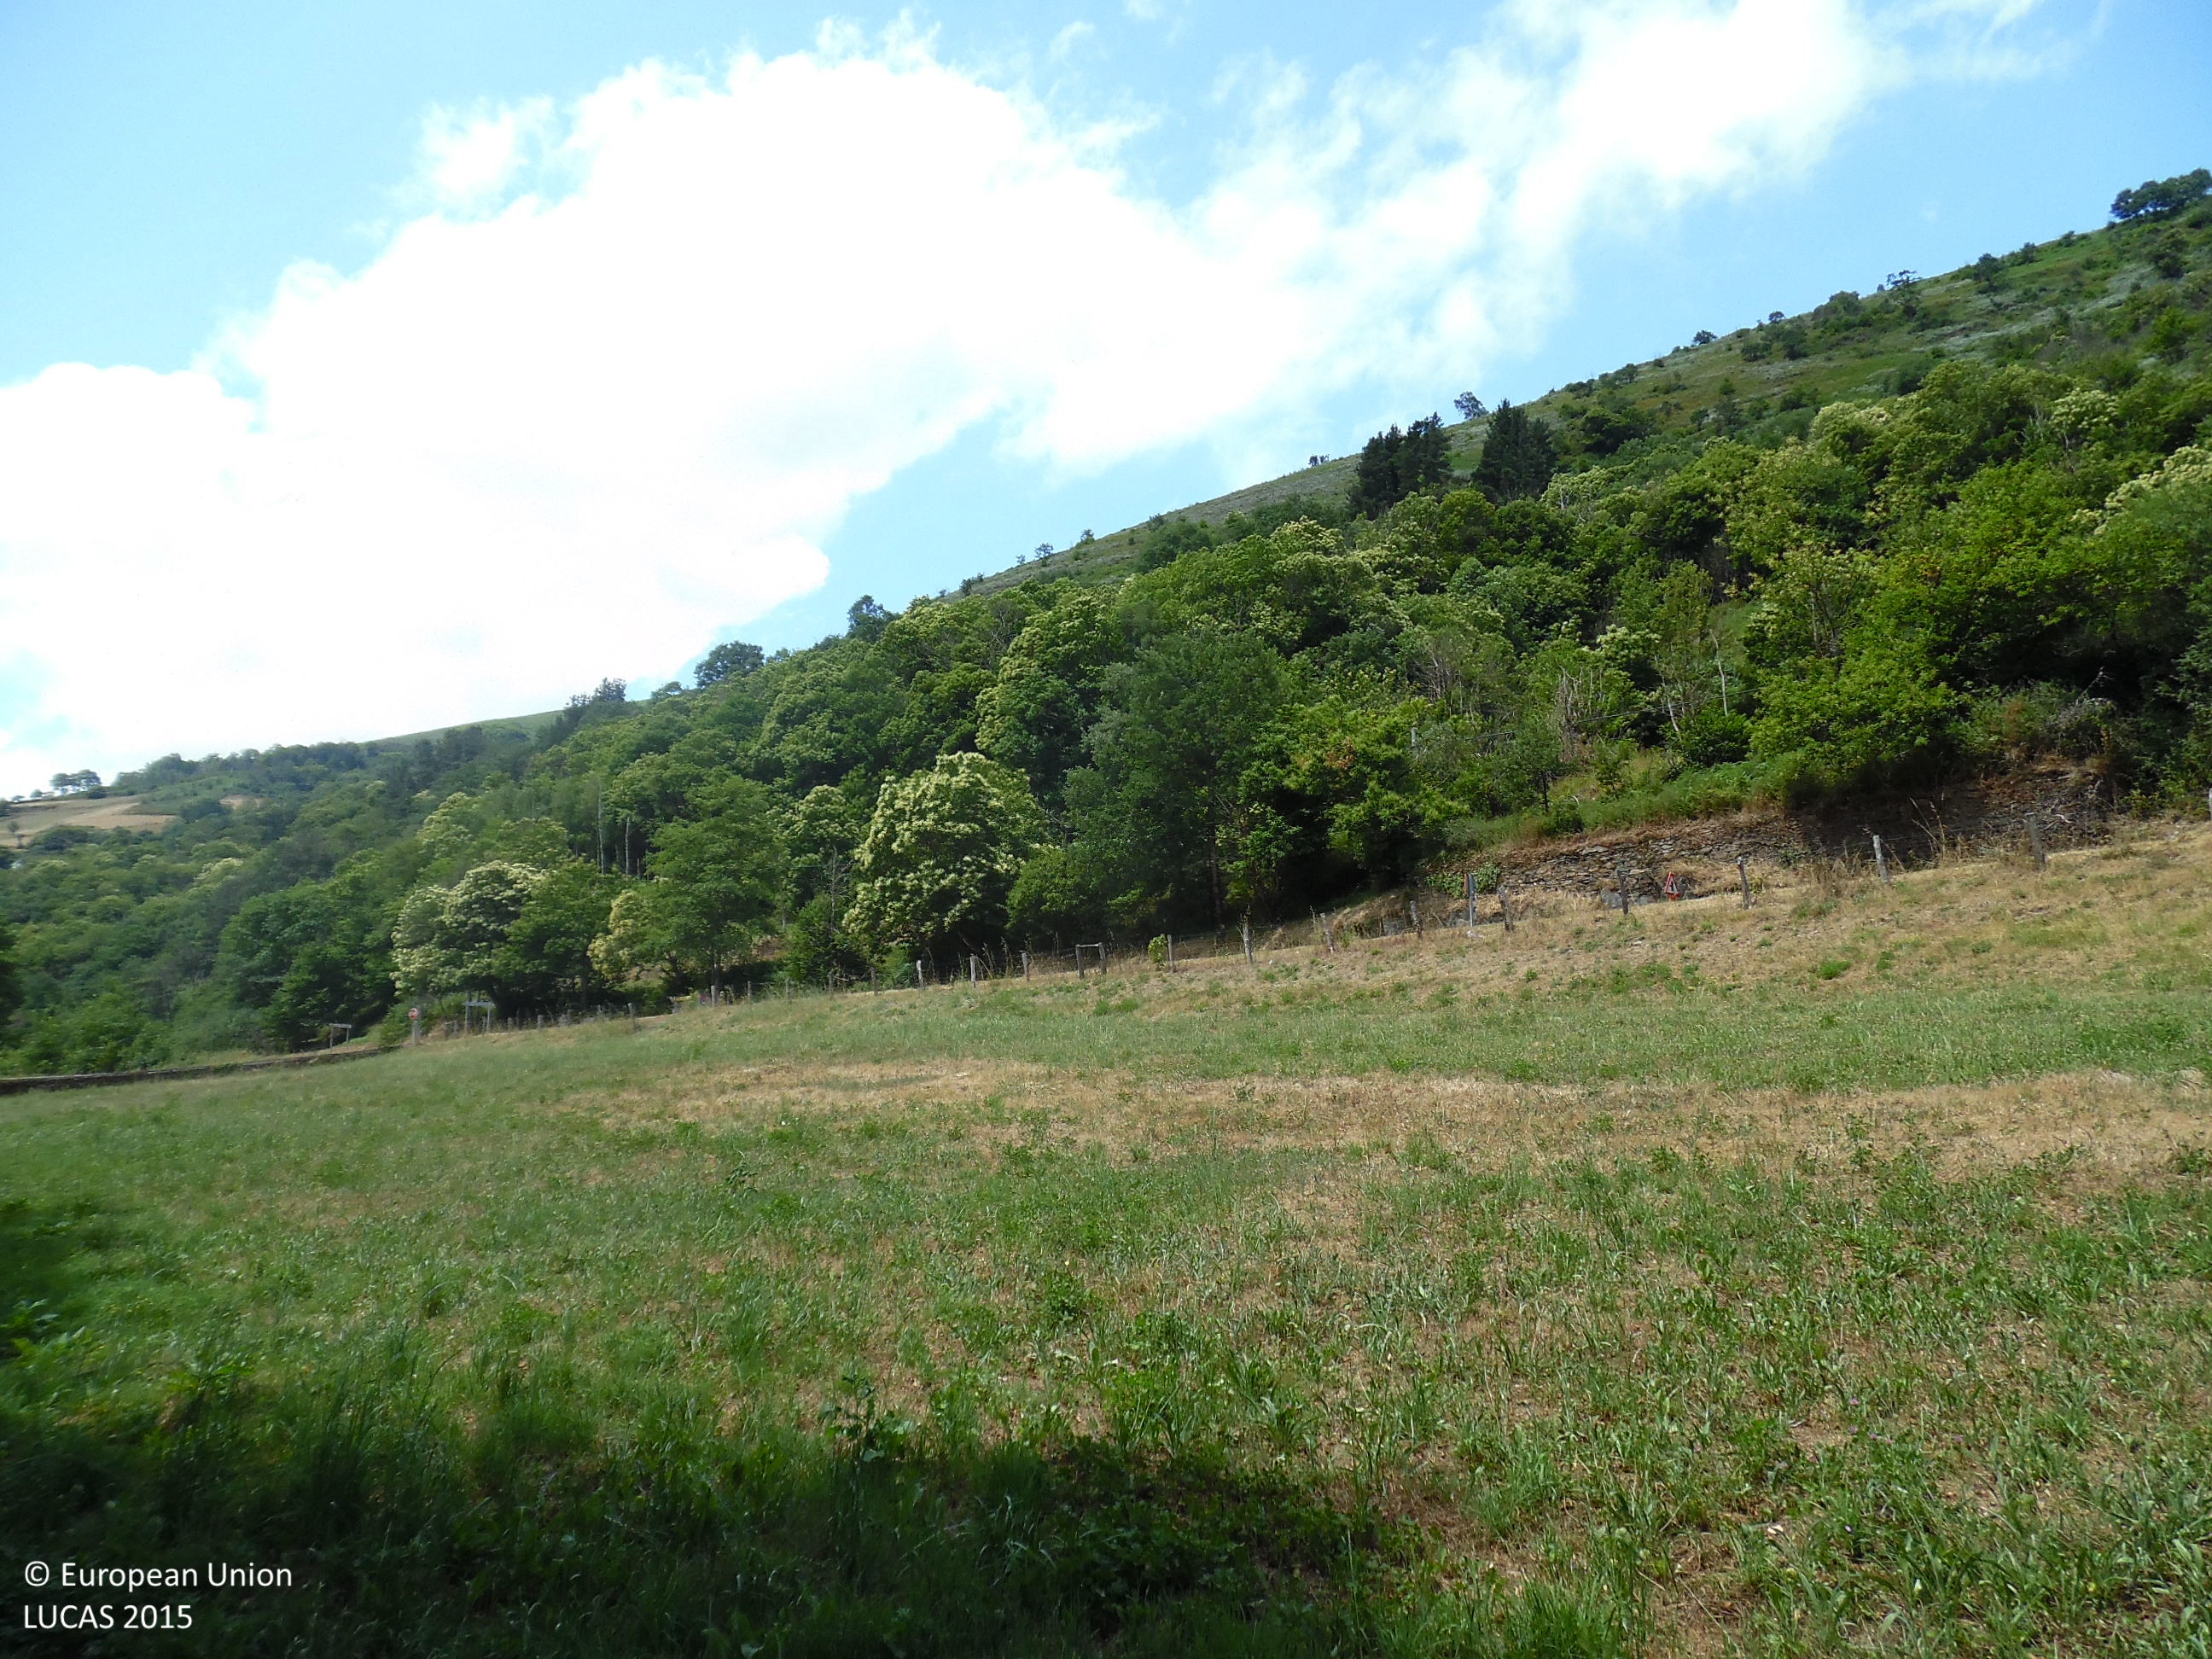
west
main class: Grassland
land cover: Grassland without tree/shrub cover
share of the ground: 25 - 50 %
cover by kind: herbaceous plants 100 %
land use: Agriculture (excluding fallow land and kitchen gardens)
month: July
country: ES
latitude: 43.1153
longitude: -6.5826
